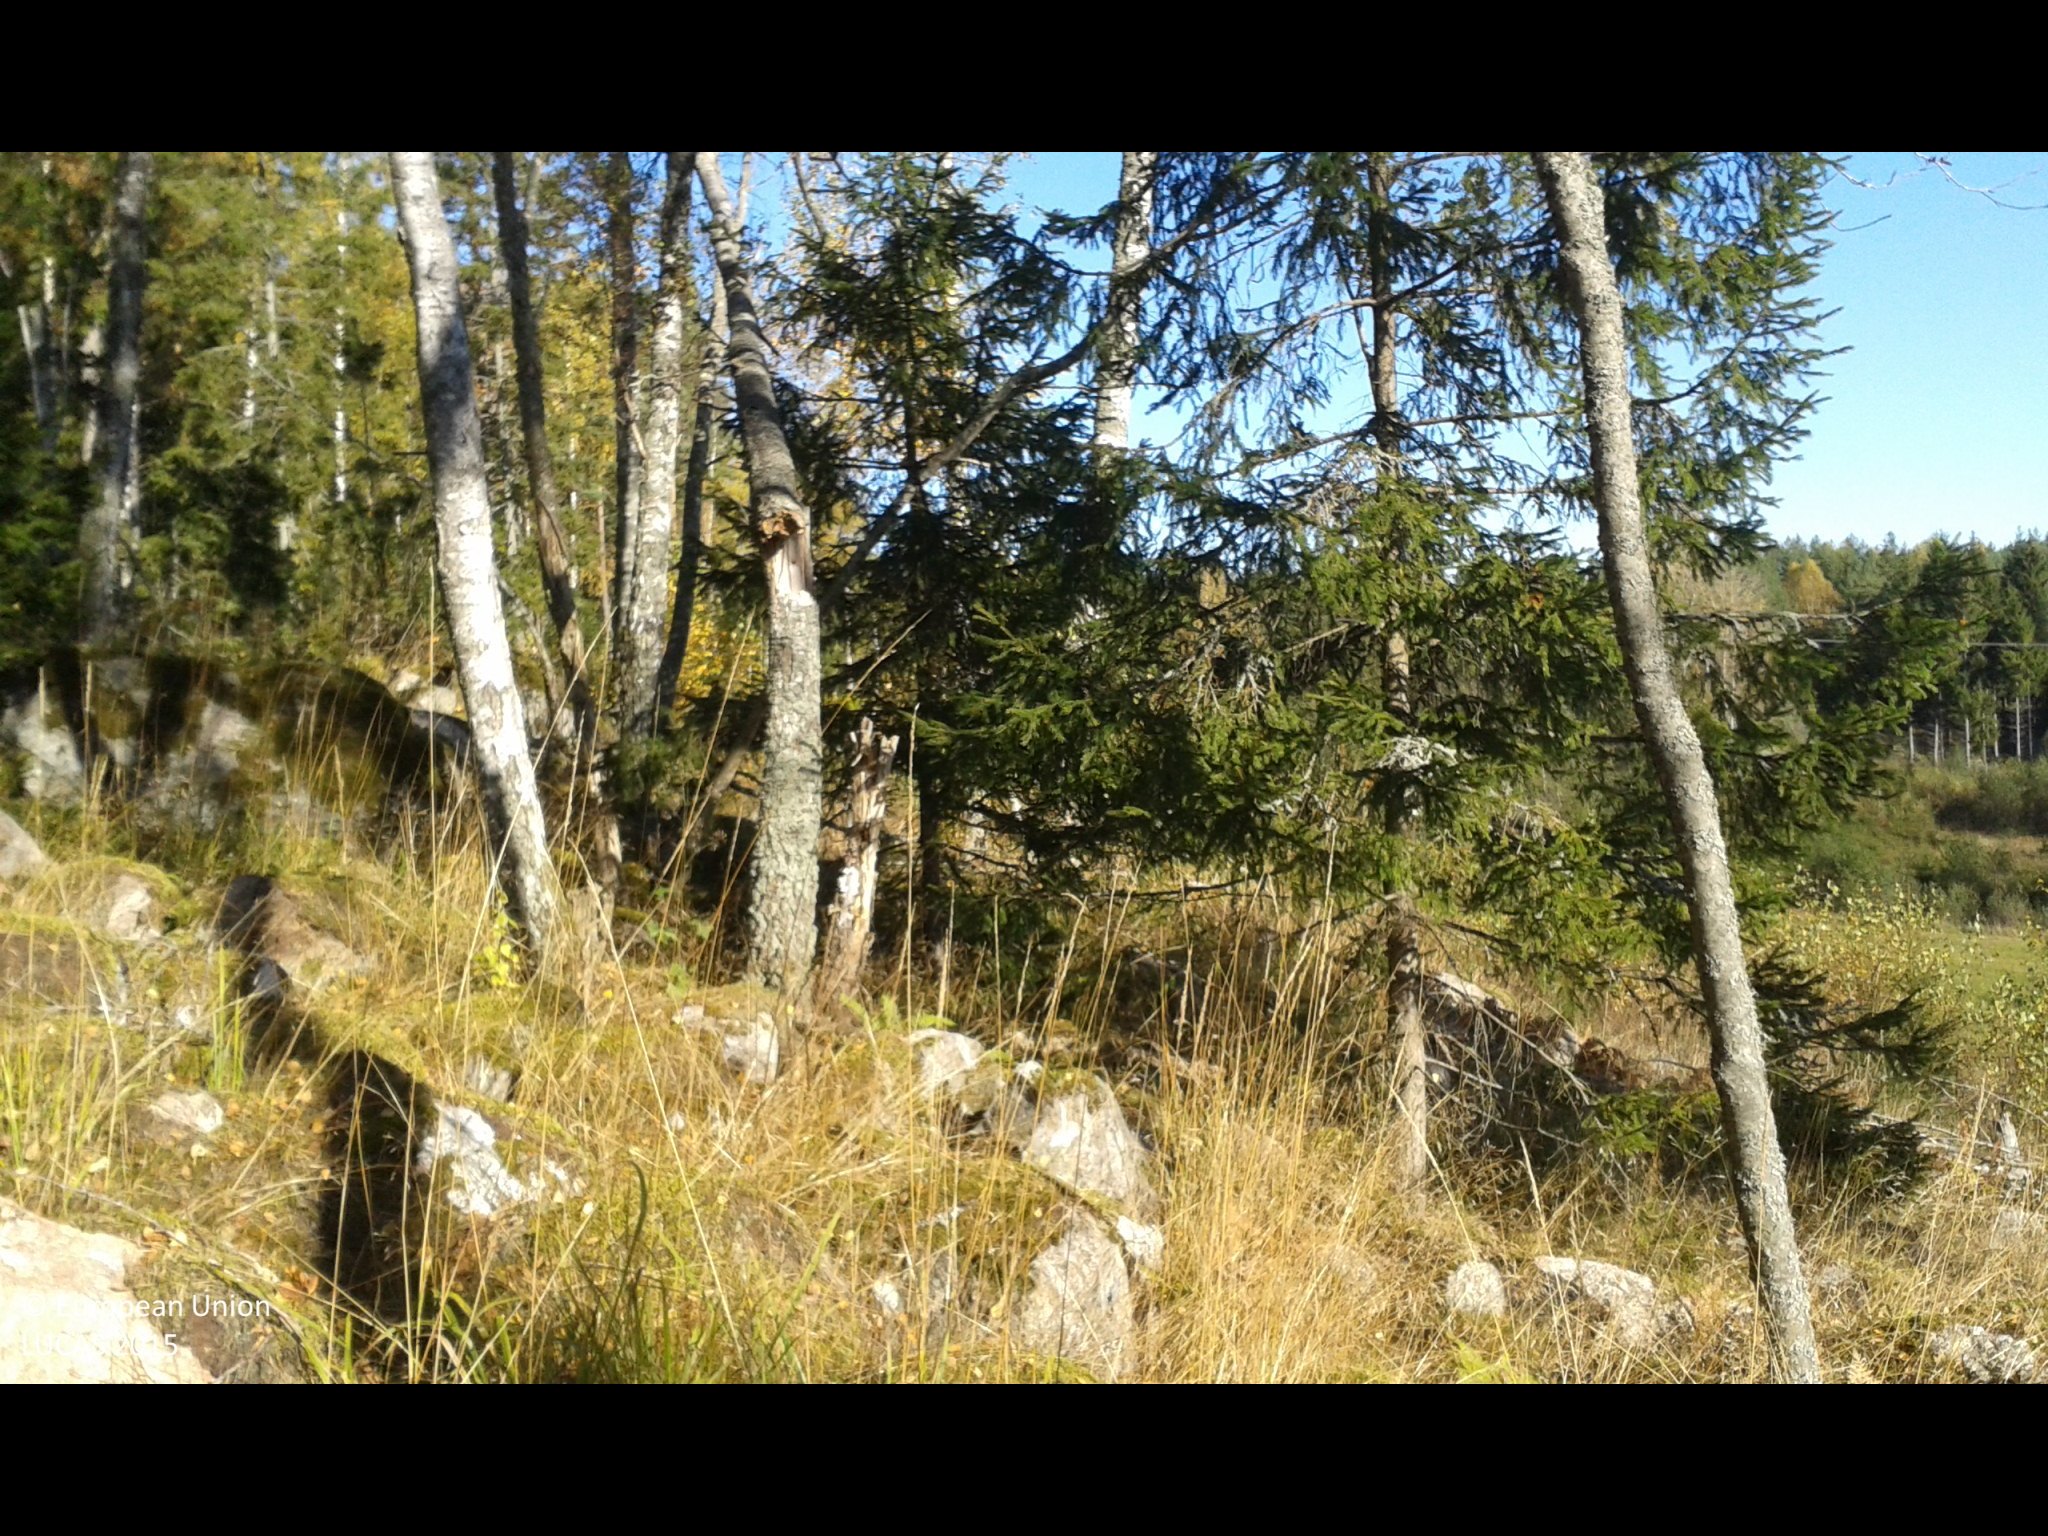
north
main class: Woodland
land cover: Spruce dominated mixed woodland
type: boreal forest
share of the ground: 25 - 50 %
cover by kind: herbaceous plants 55 %, coniferous forest trees 25 %, broadleaved forest trees 20 %
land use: Forestry
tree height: > 5 m
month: October
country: SE
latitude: 58.8329
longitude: 17.3254
